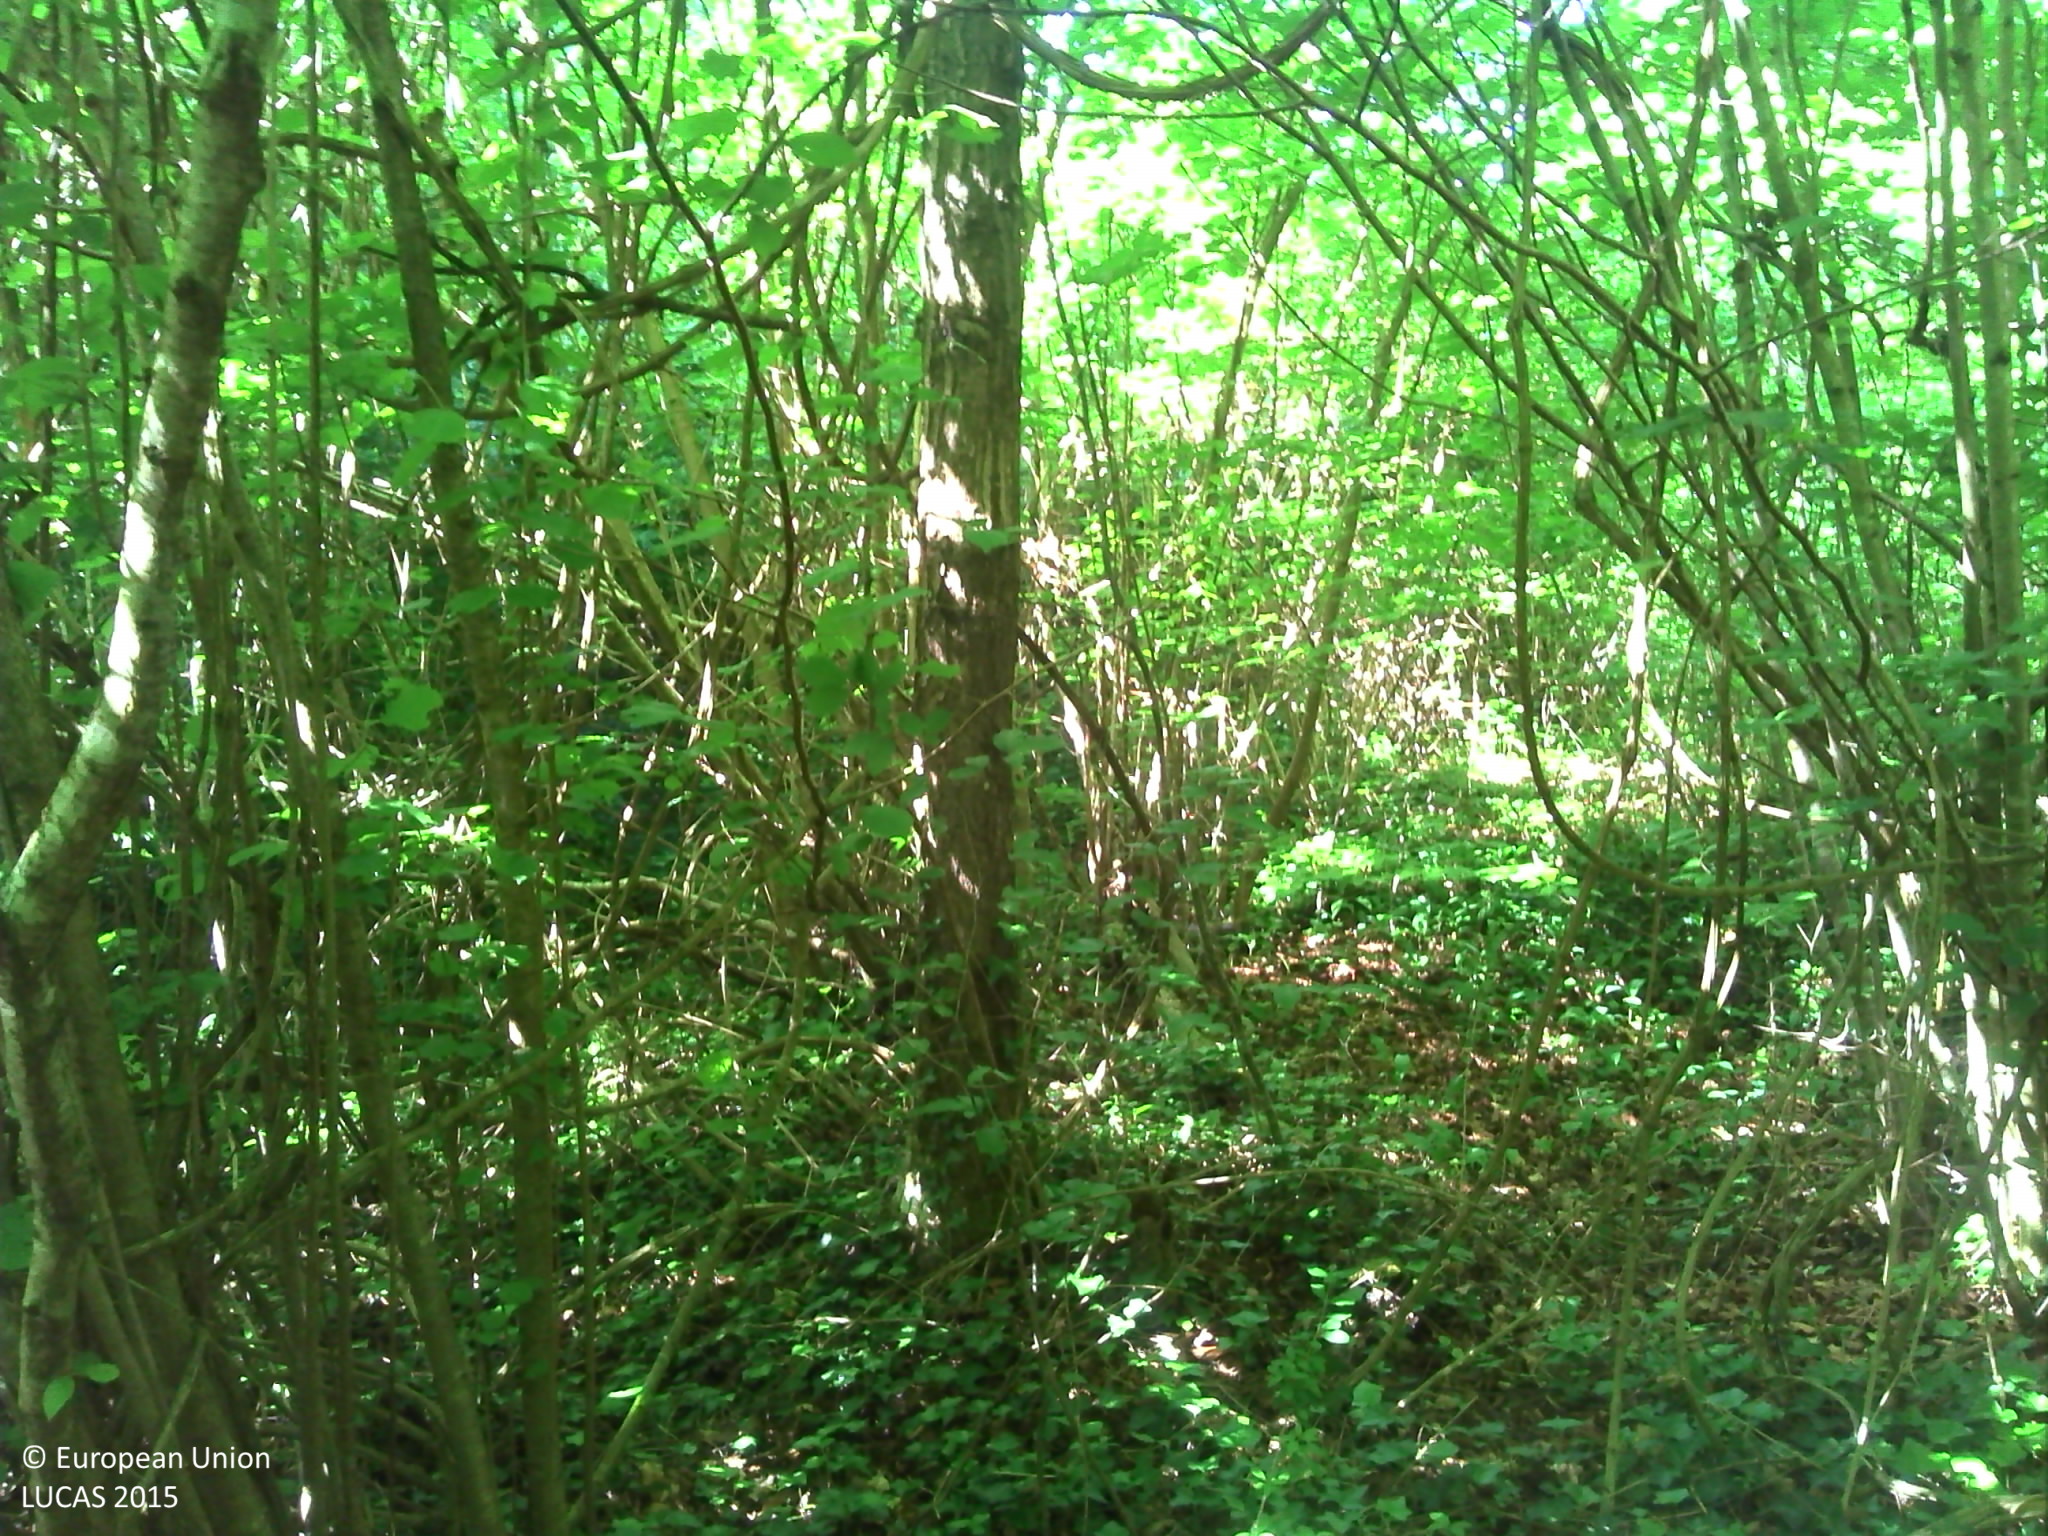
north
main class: Woodland
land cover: Broadleaved woodland
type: beech forest
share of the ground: > 75 %
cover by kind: broadleaved forest trees 90 %, coniferous forest trees 10 %
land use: Forestry
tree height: > 5 m
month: June
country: FR
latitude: 49.4085
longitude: 3.2800
